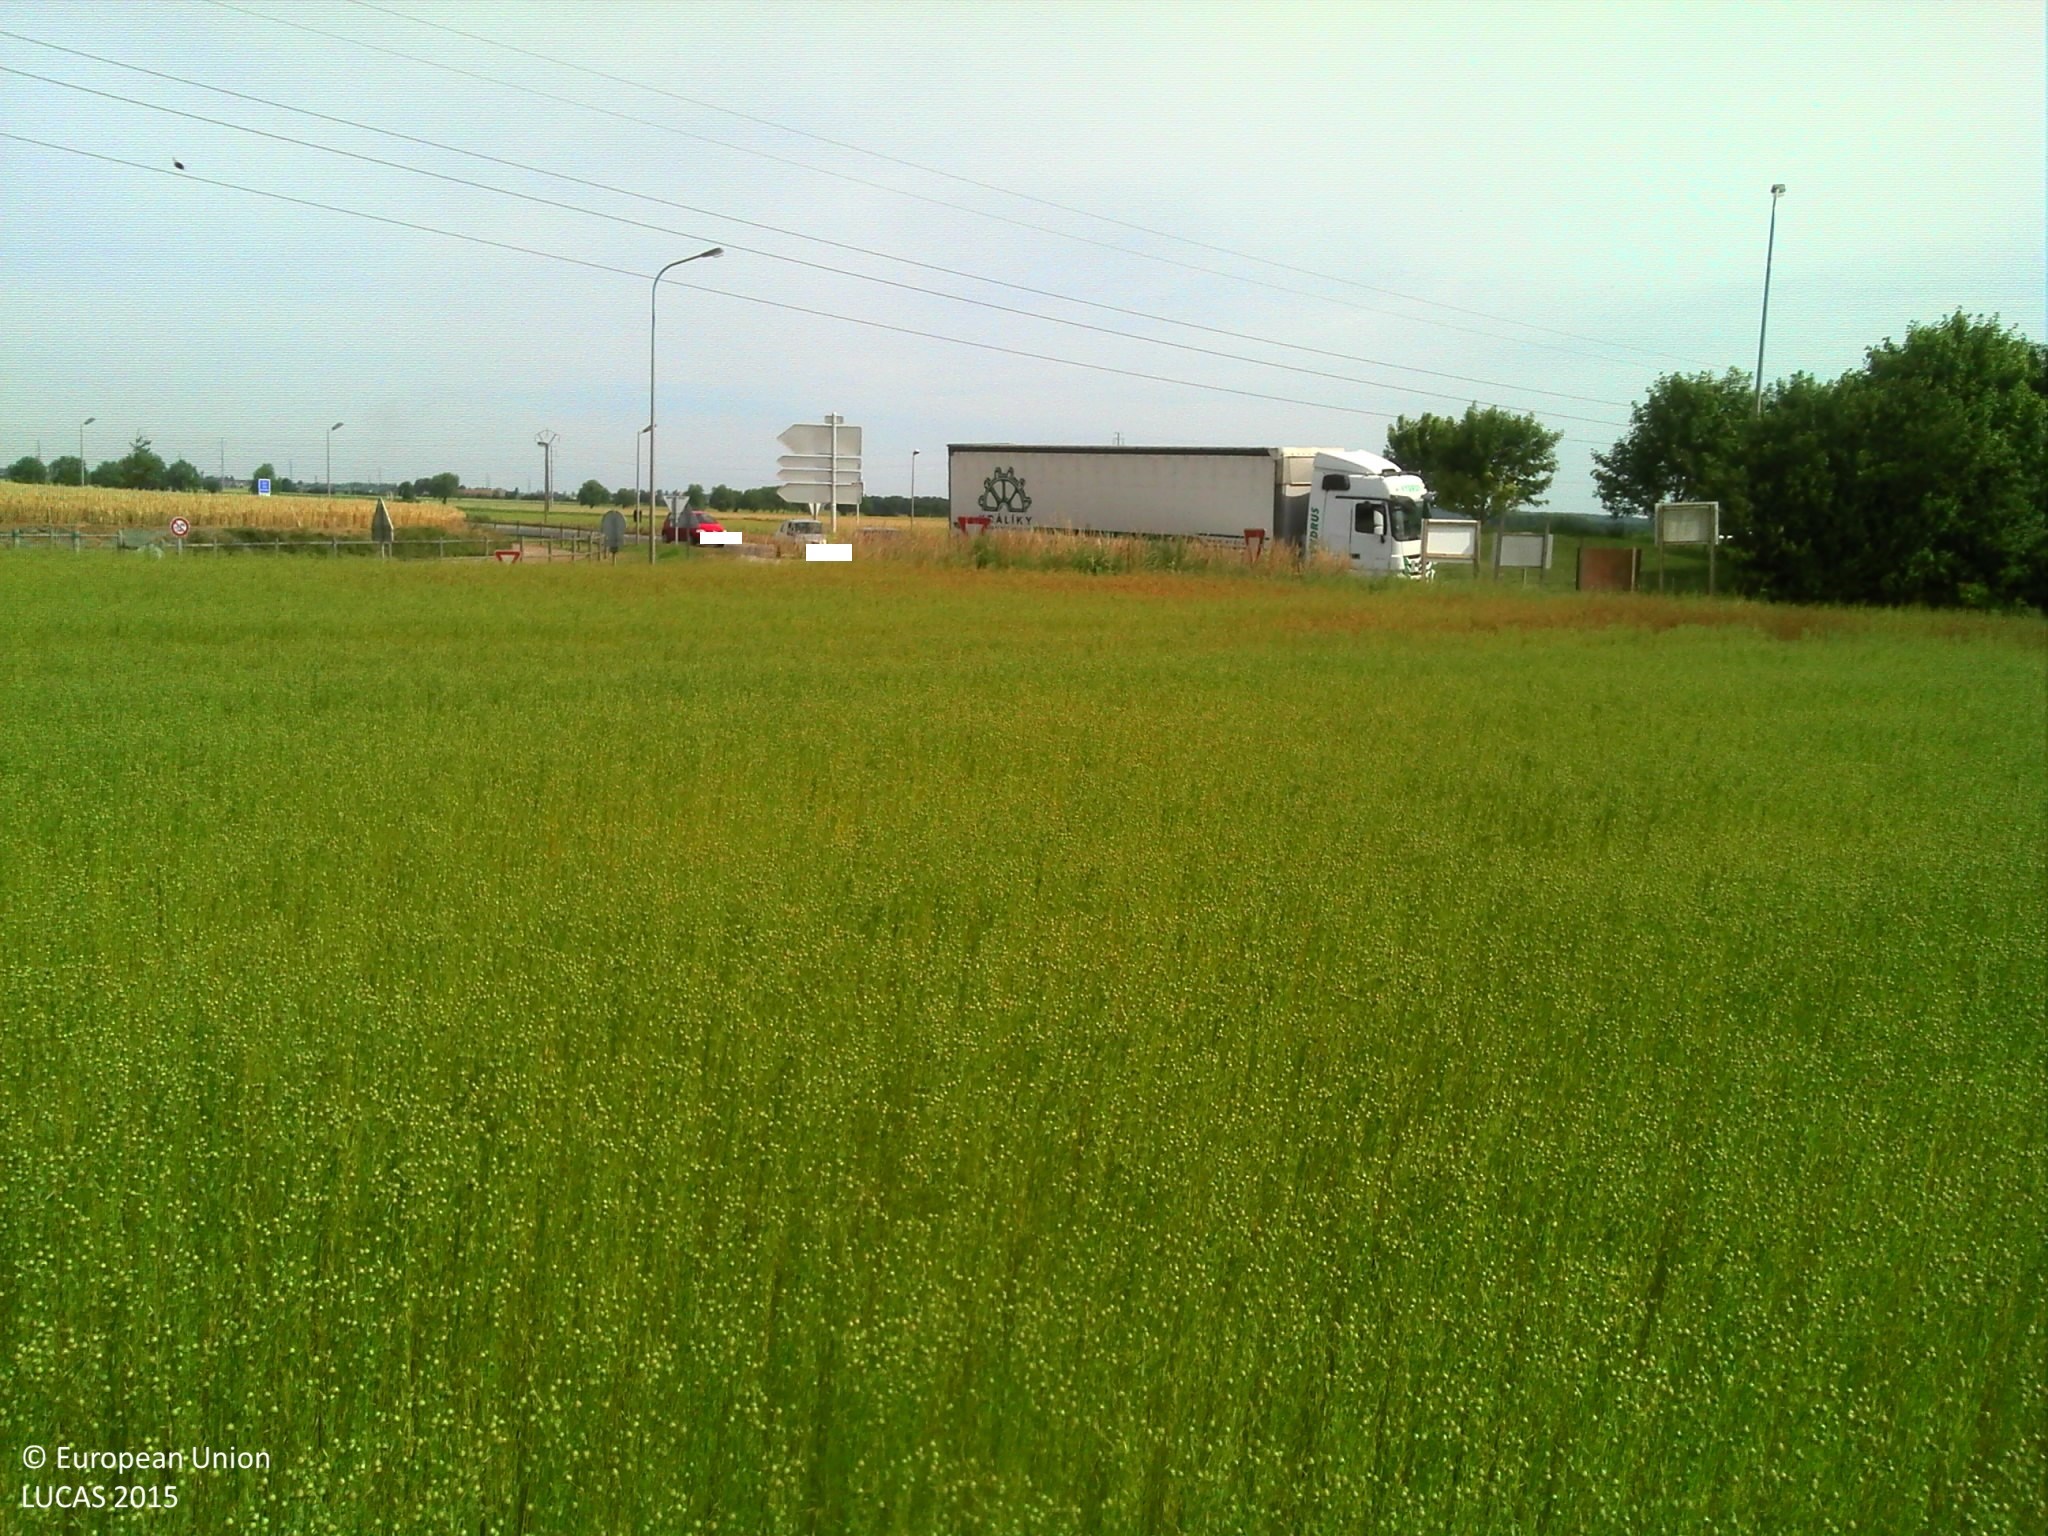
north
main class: Cropland
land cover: Other fibre and oleaginous crops
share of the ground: > 75 %
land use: Agriculture (excluding fallow land and kitchen gardens)
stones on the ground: < 10 %
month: June
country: FR
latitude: 49.1413
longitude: -0.2458
